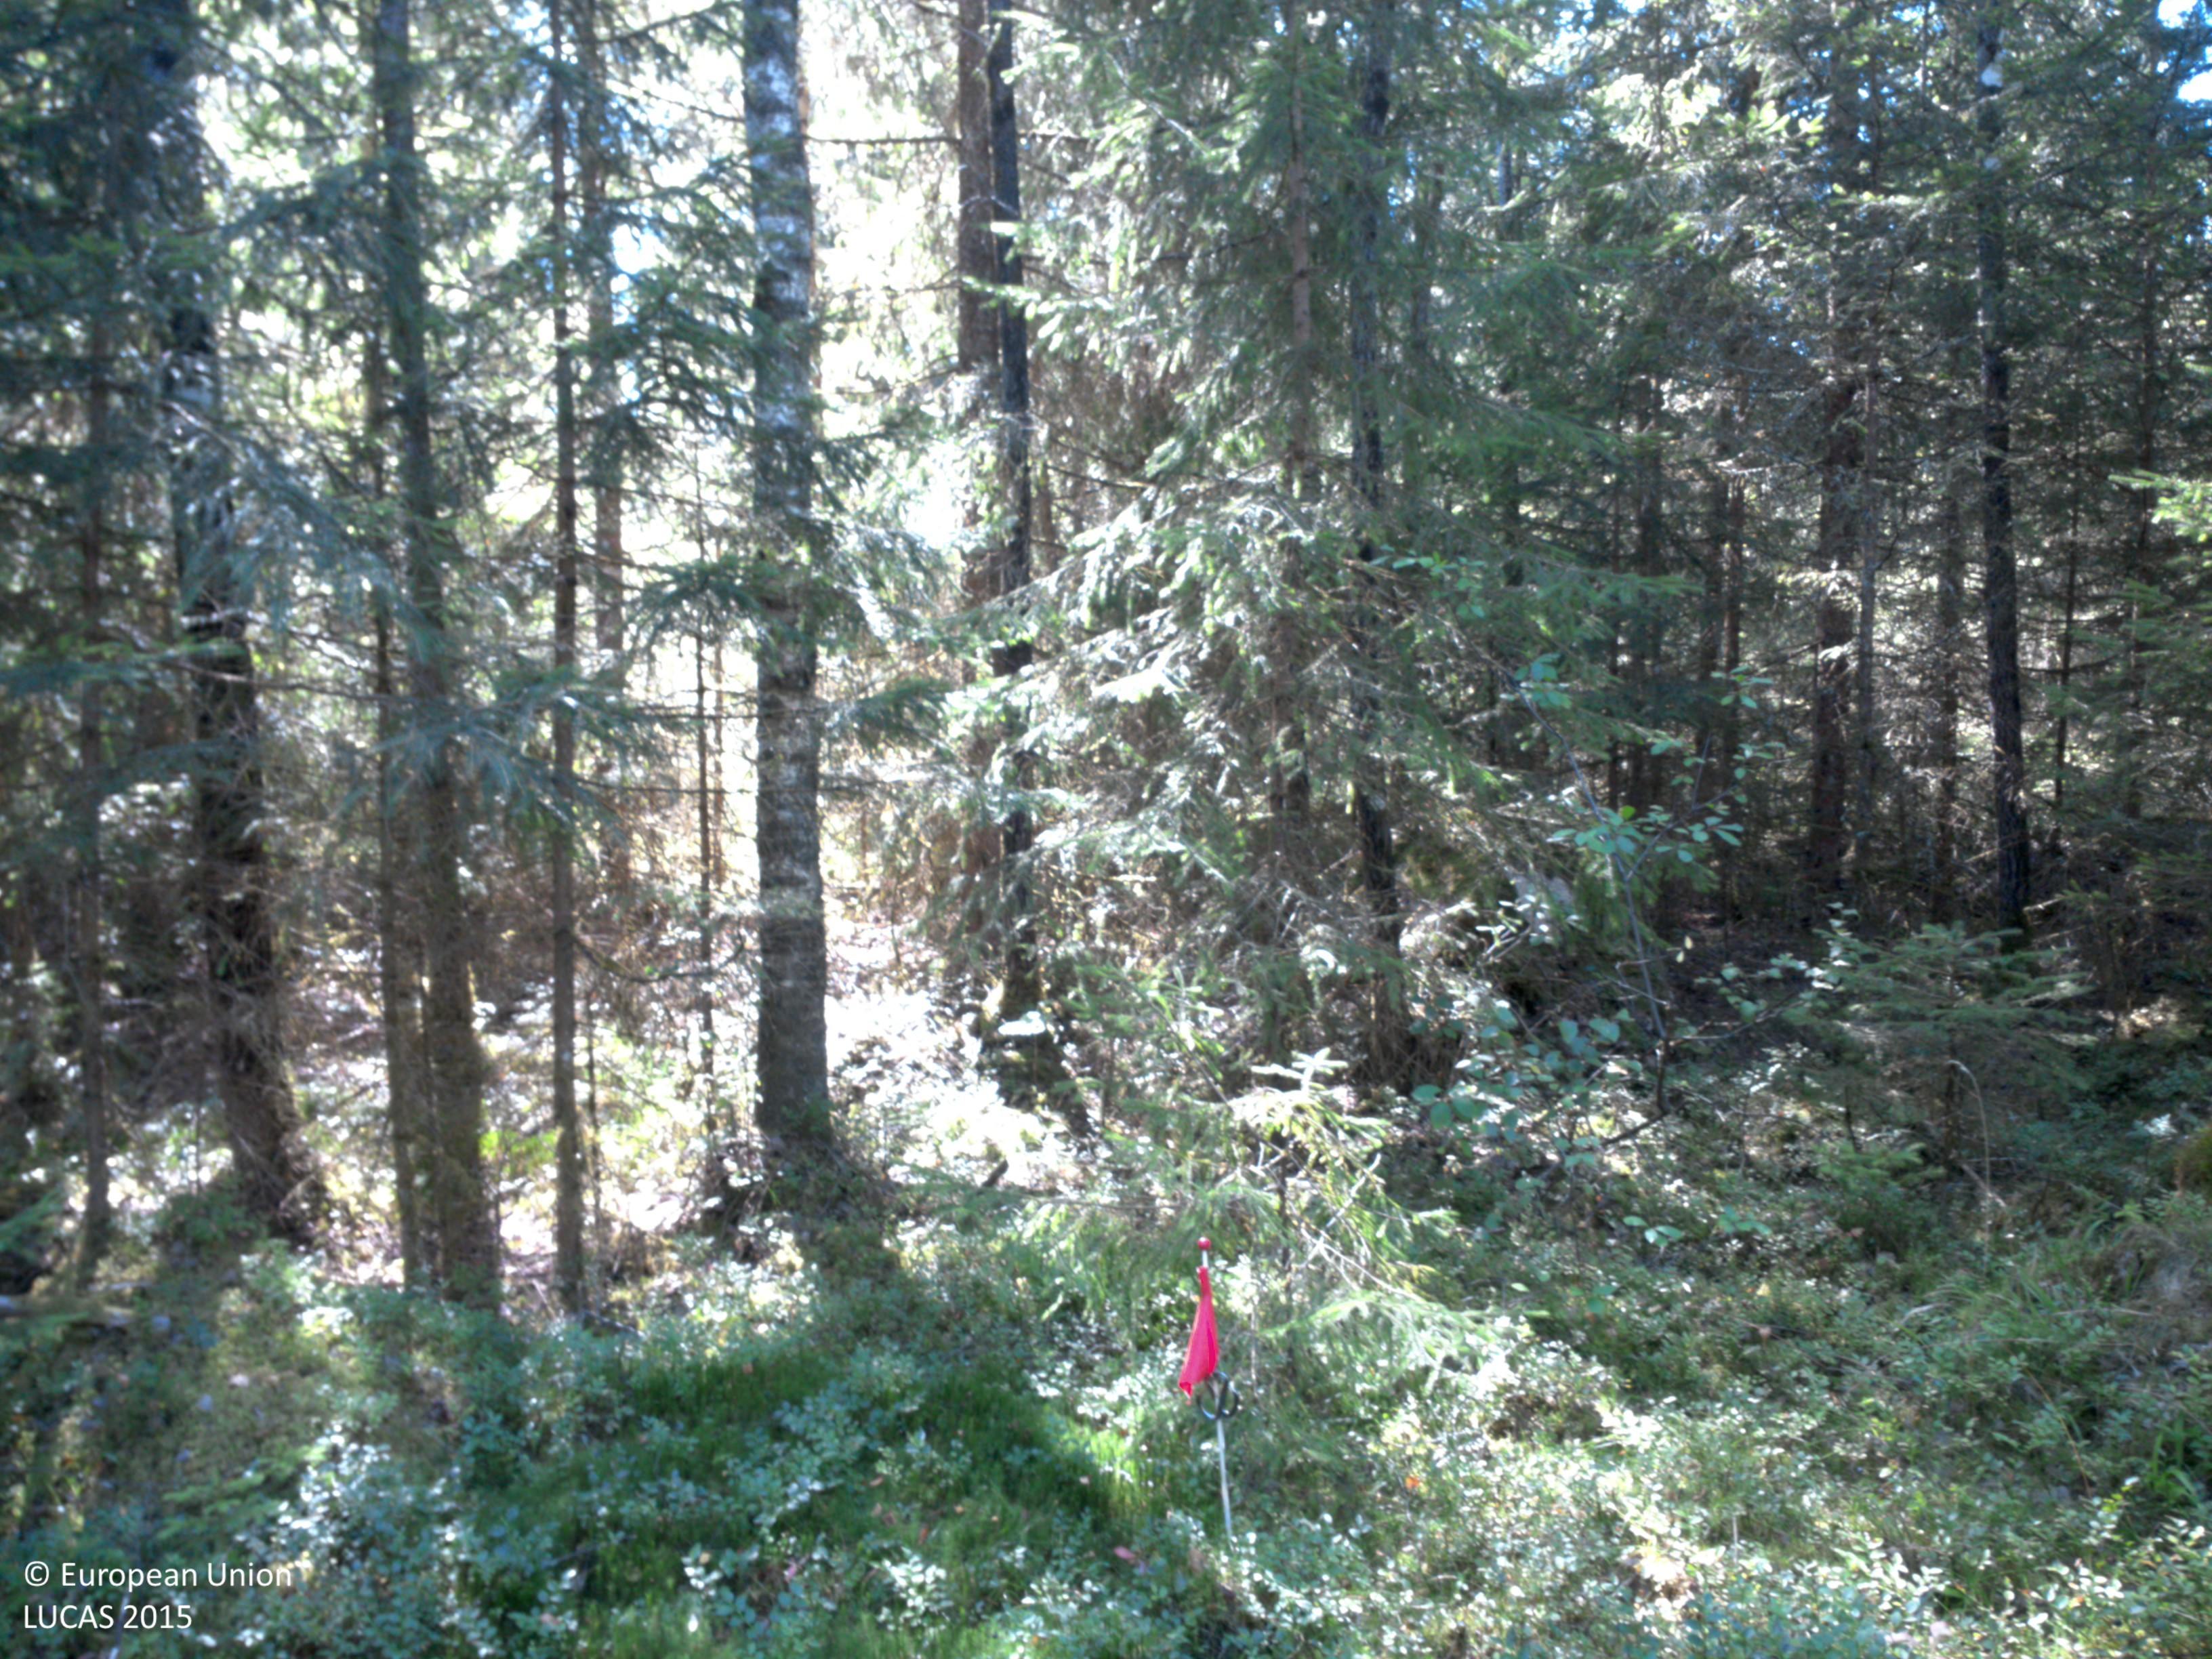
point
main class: Woodland
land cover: Spruce dominated mixed woodland
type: boreal forest
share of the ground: 50 - 75 %
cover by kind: coniferous forest trees 45 %, herbaceous plants 30 %, broadleaved forest trees 25 %
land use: Forestry
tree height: > 5 m
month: August
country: SE
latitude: 58.5474
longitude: 11.9375
